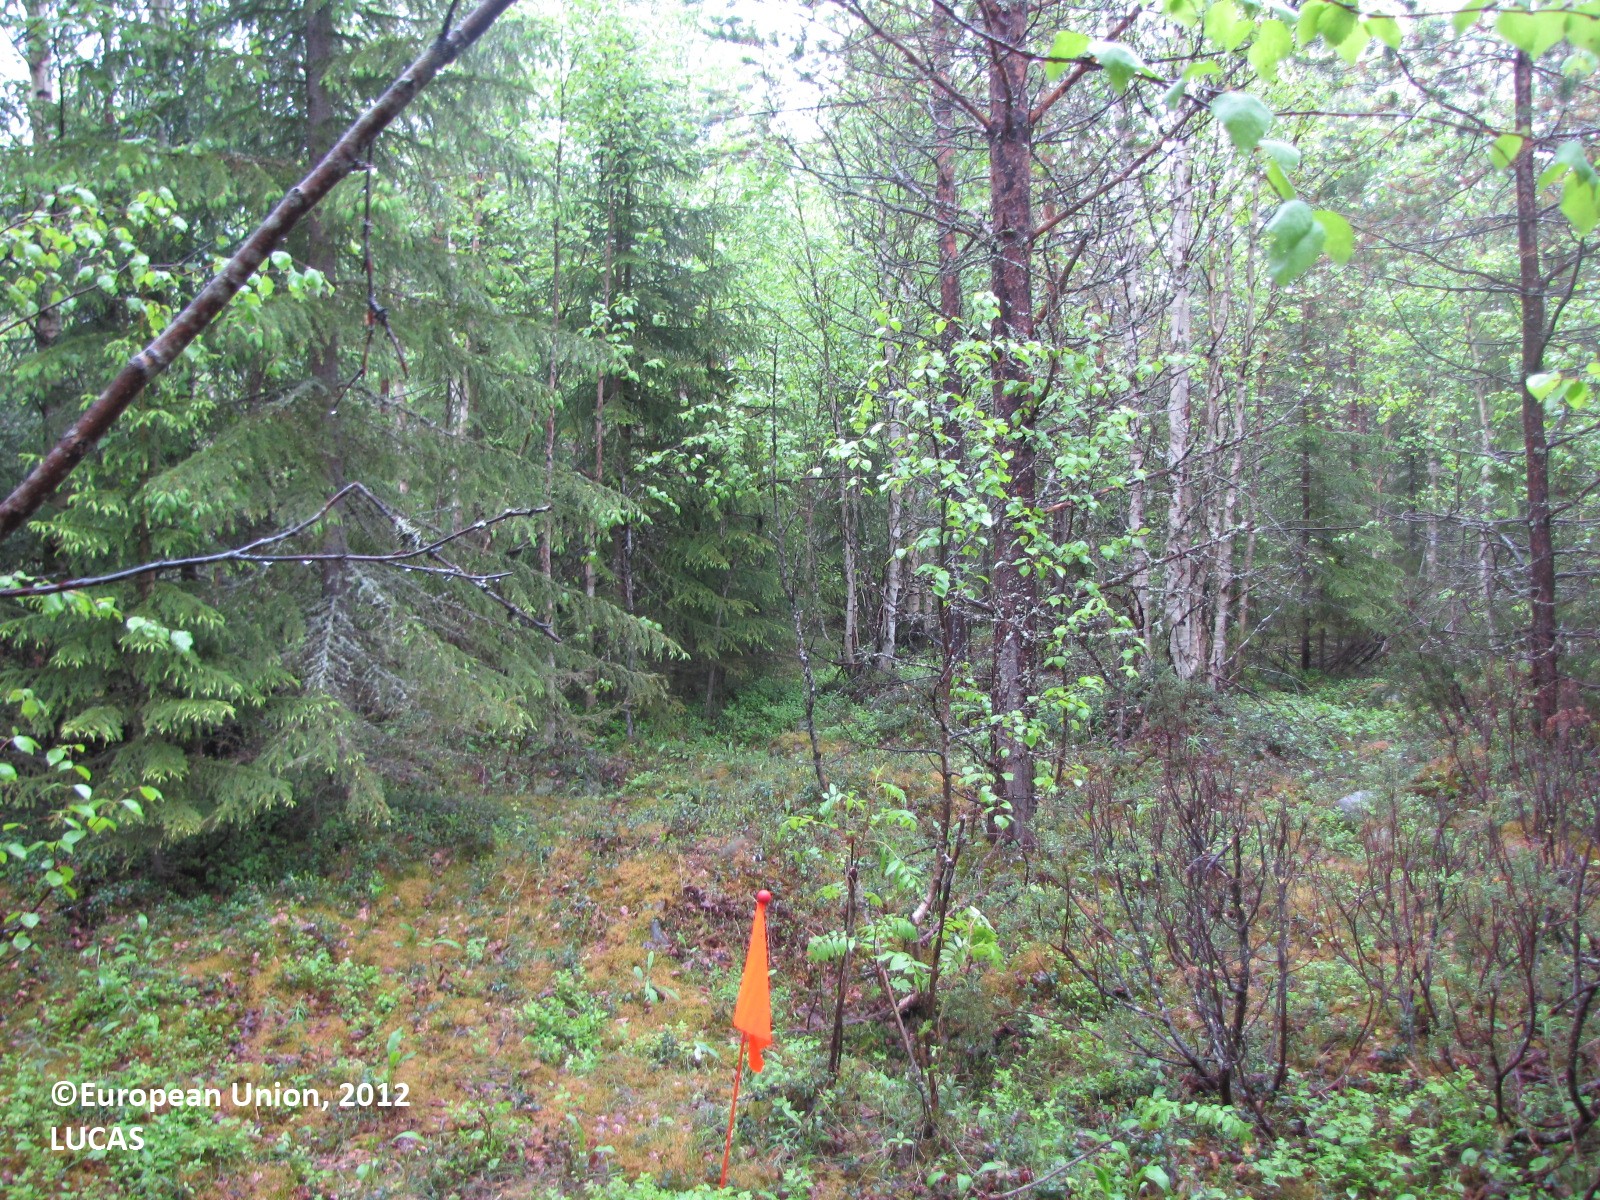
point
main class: Woodland
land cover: Other mixed woodland
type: boreal forest
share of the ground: 50 - 75 %
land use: Forestry
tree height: > 5 m
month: June
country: FI
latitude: 66.0521
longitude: 24.2873
